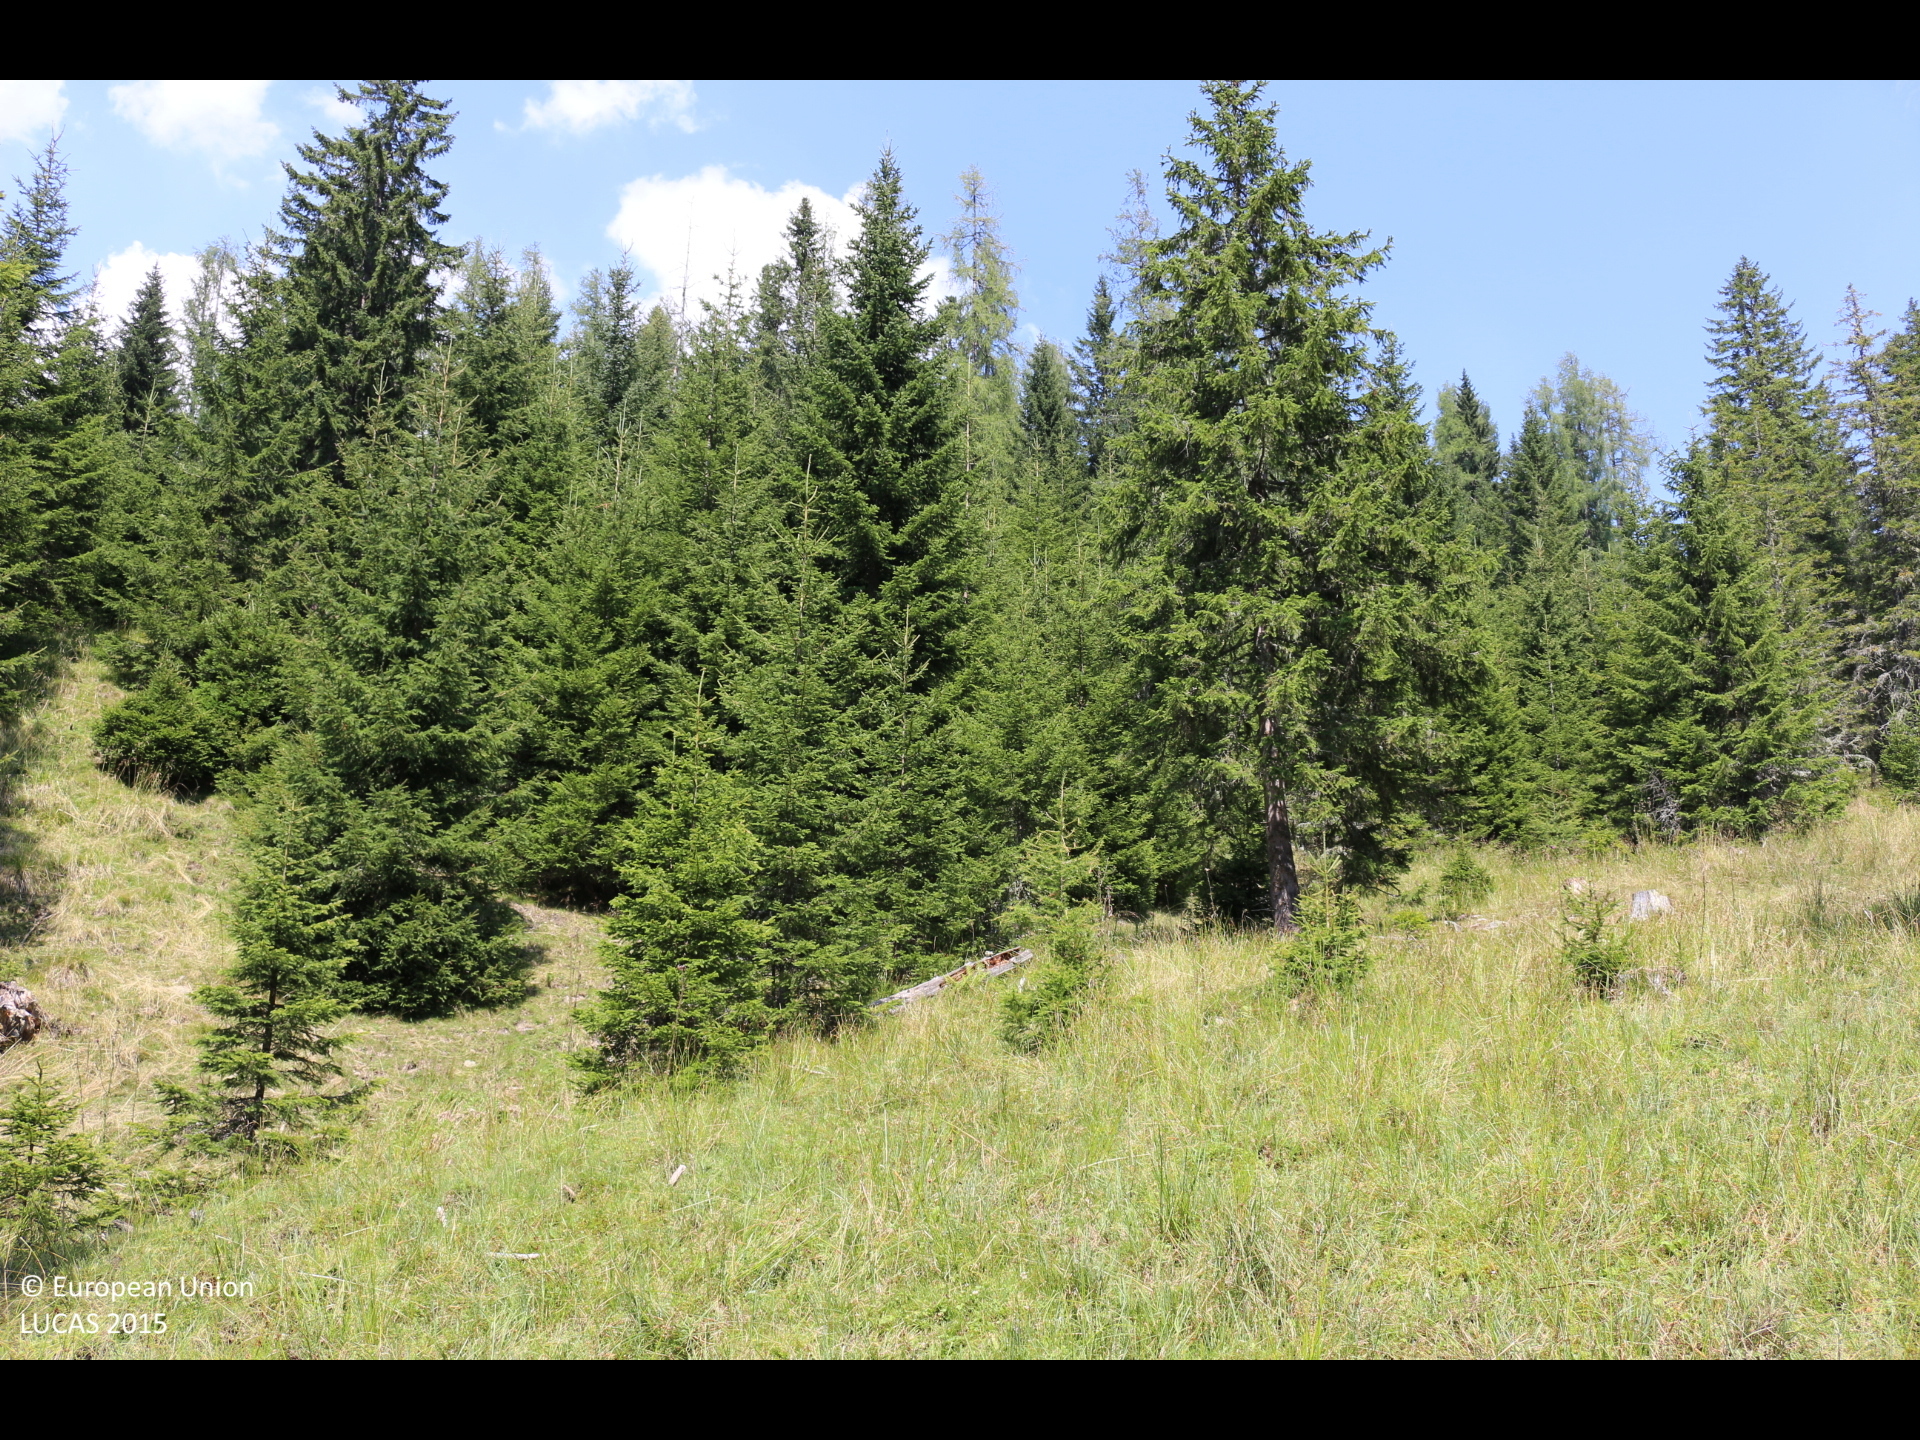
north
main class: Grassland
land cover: Grassland with sparse tree/shrub cover
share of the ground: > 75 %
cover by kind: herbaceous plants 95 %, coniferous forest trees 5 %
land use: Agriculture (excluding fallow land and kitchen gardens)
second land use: Forestry
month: August
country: AT
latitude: 46.8545
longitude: 13.9717
